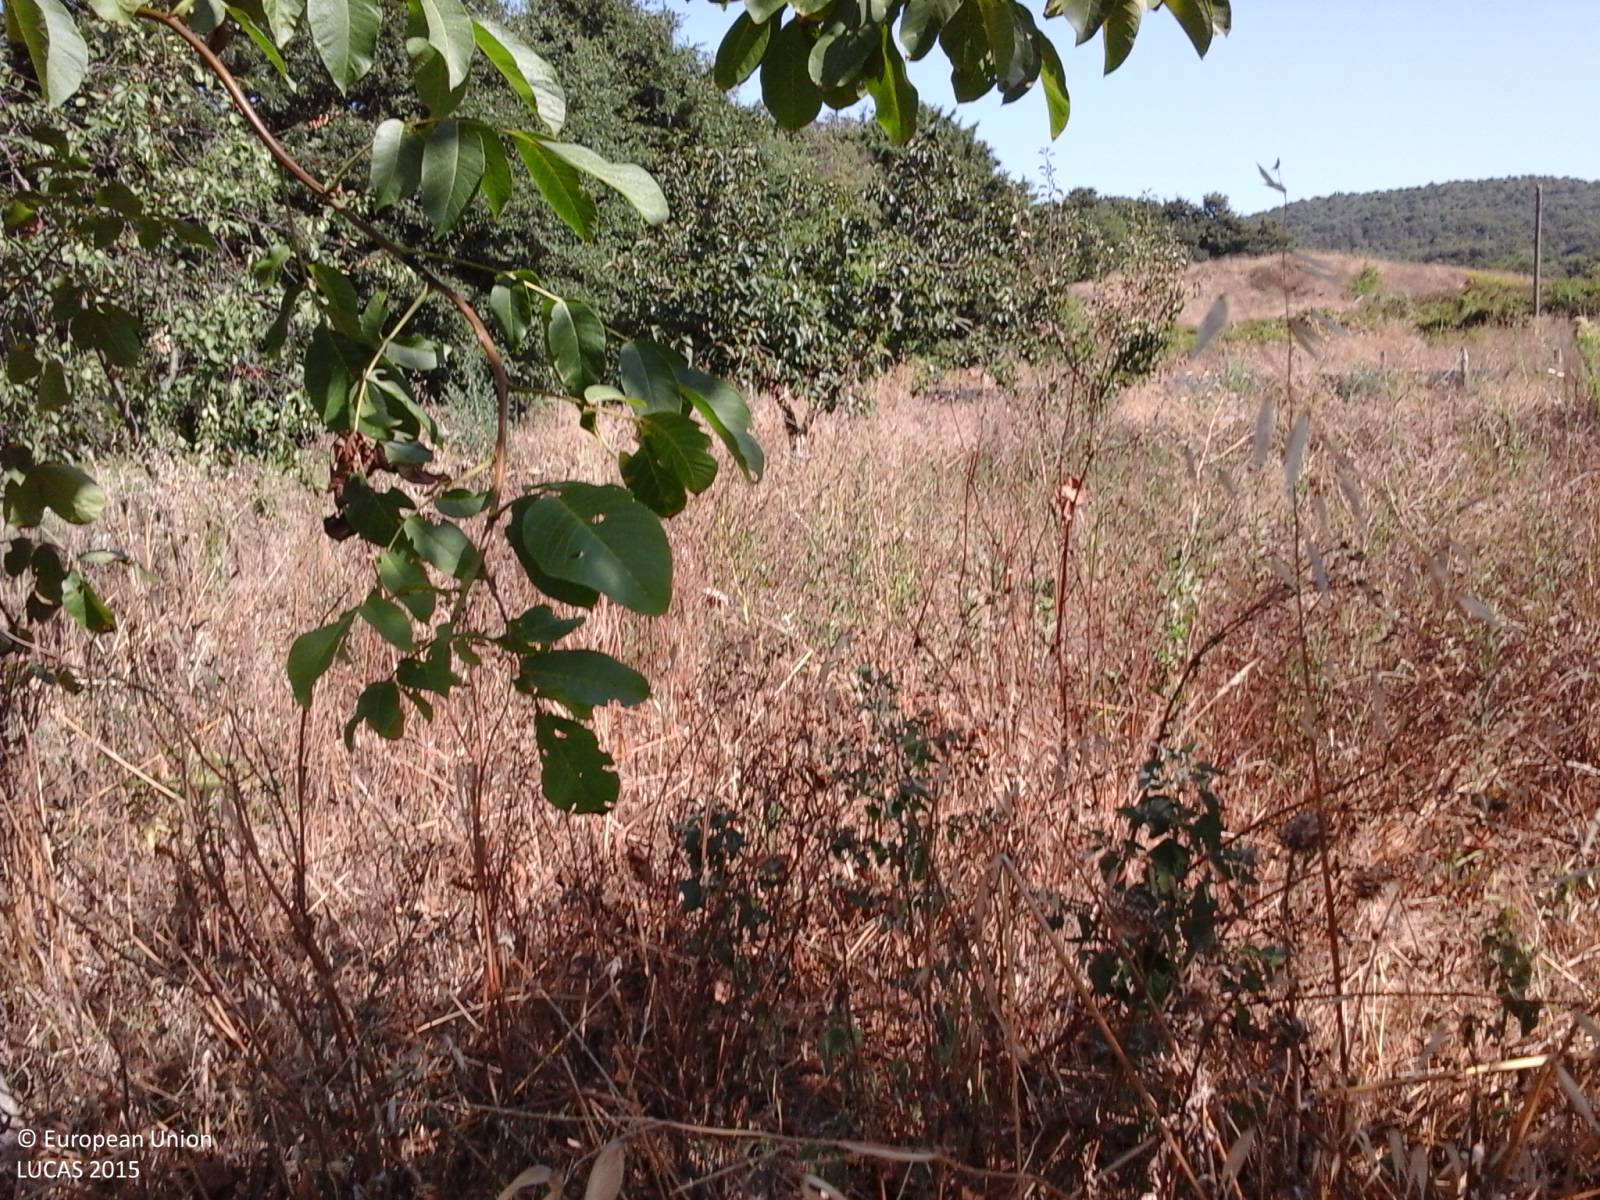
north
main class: Grassland
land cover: Grassland with sparse tree/shrub cover
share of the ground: > 75 %
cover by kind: herbaceous plants 95 %, broadleaved forest trees 5 %
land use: Agriculture (excluding fallow land and kitchen gardens)
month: August
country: IT
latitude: 42.1585
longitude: 12.2793
